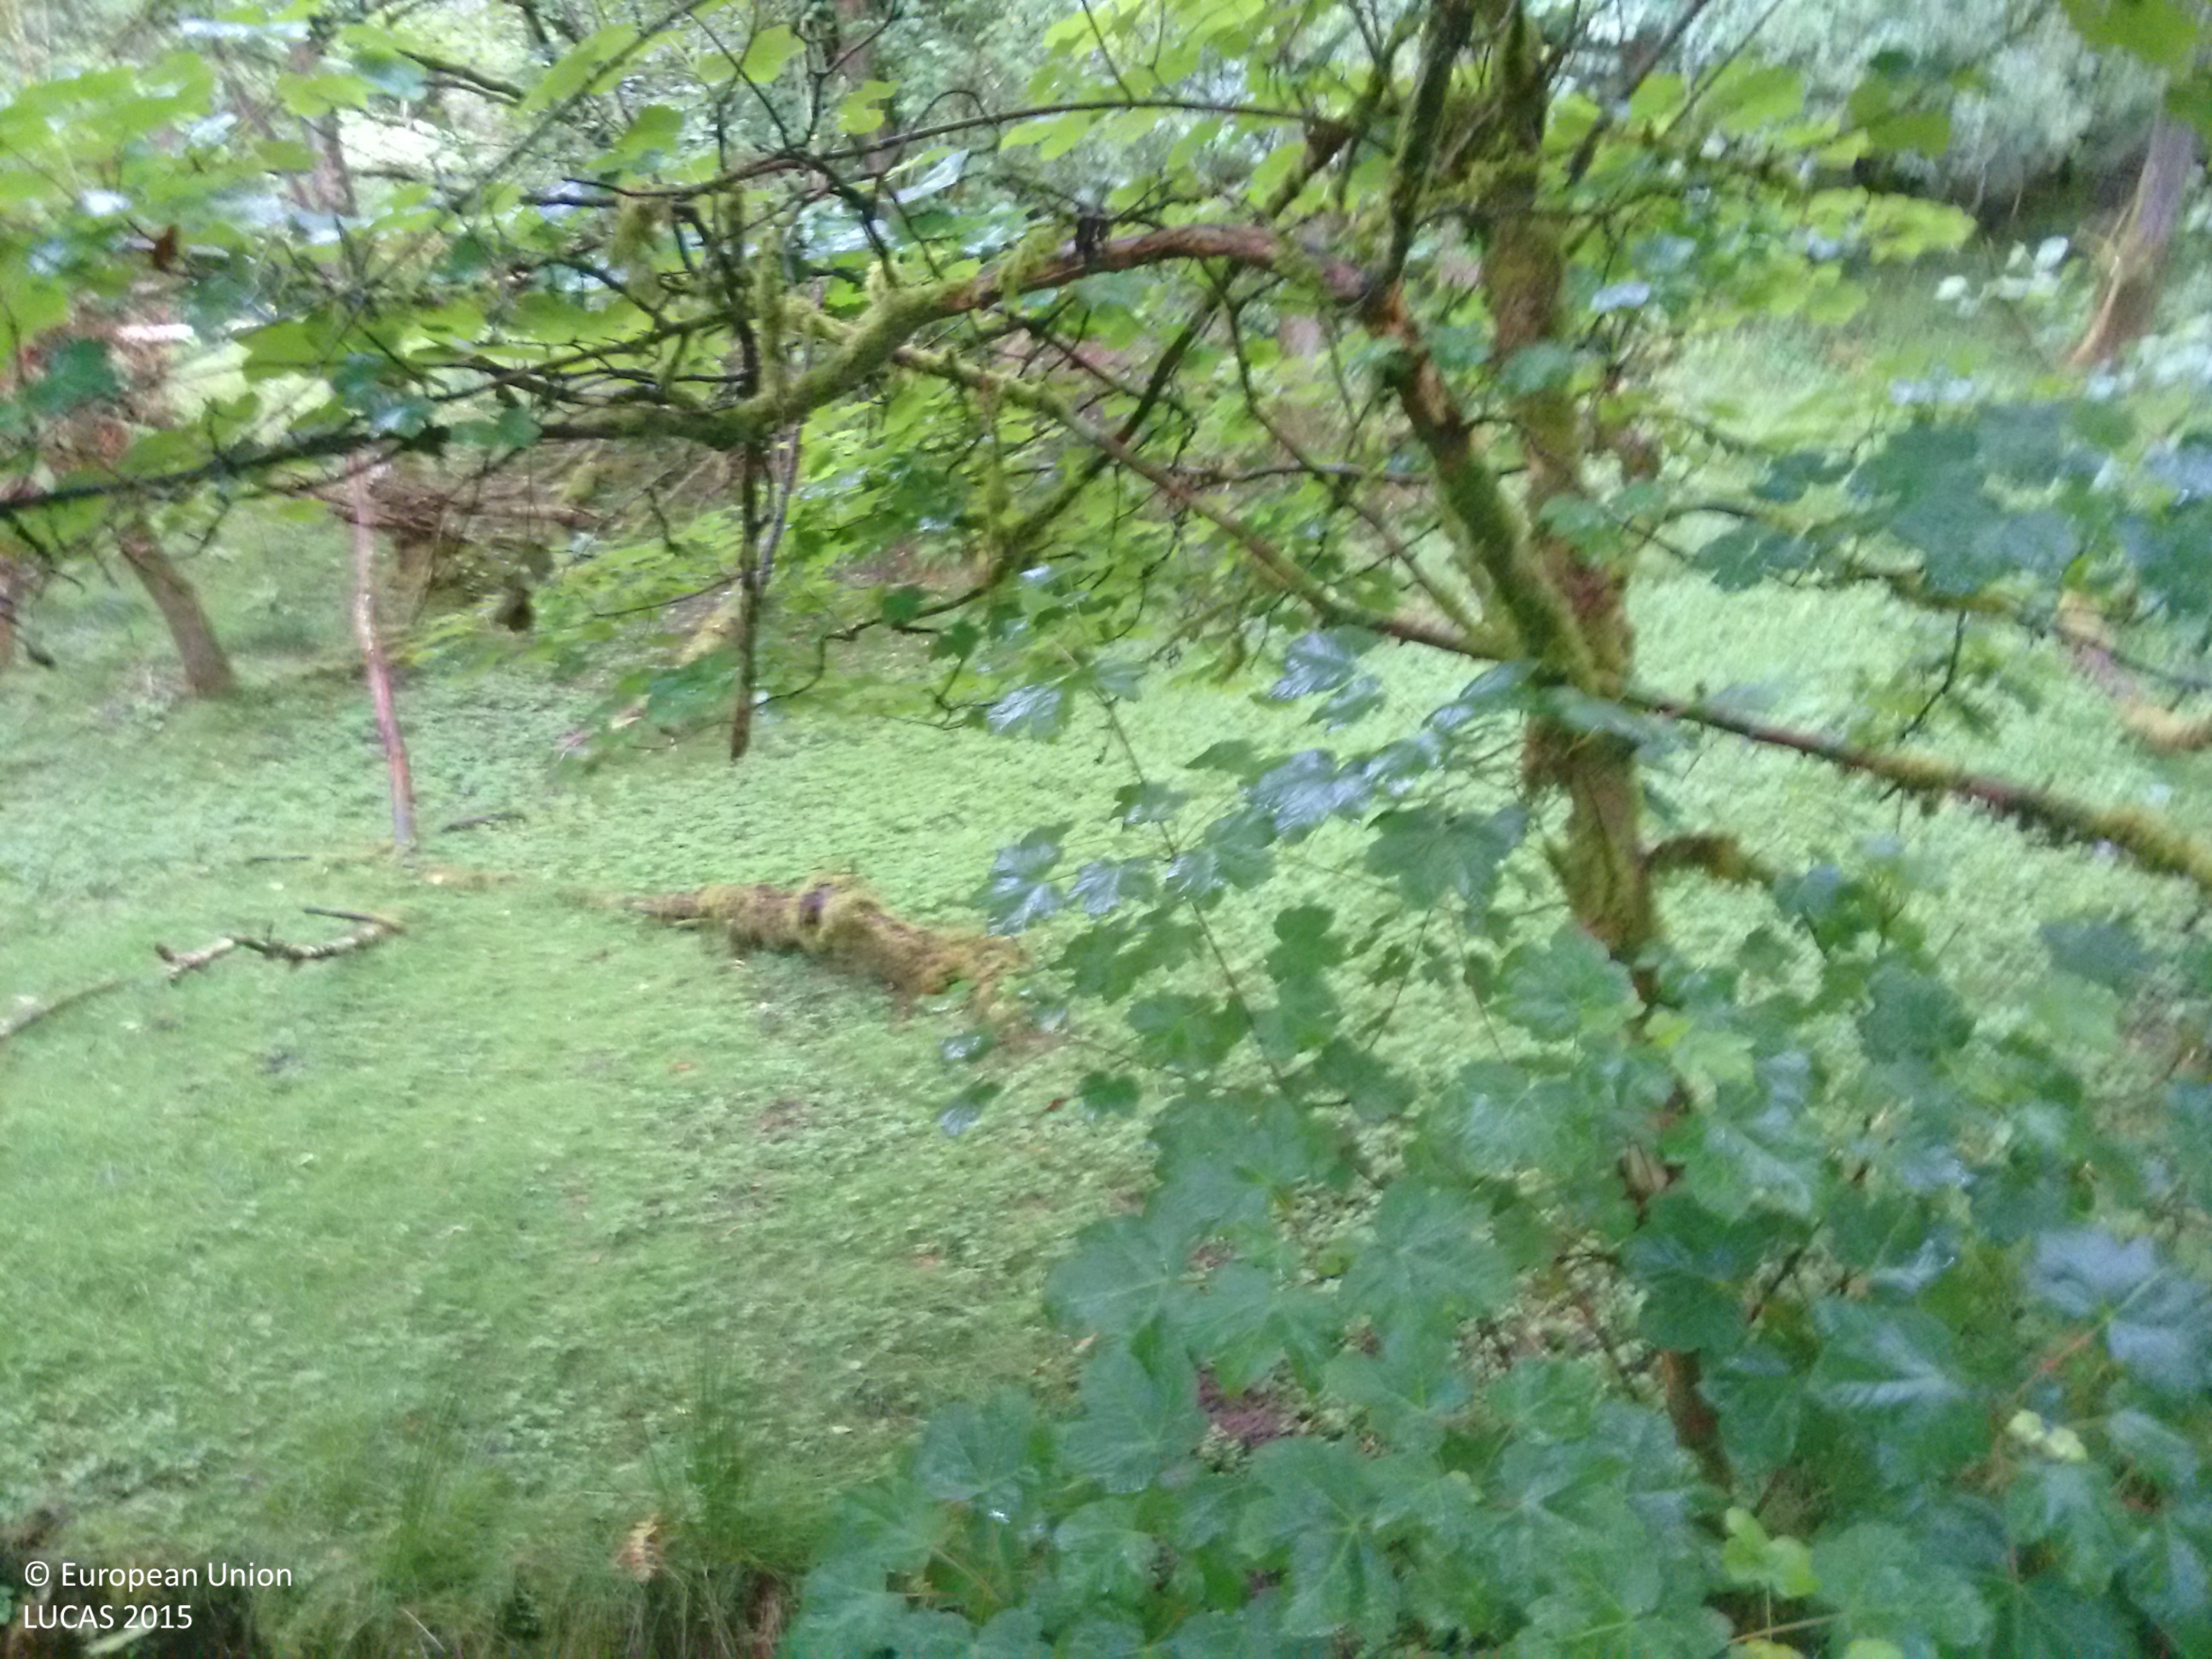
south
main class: Woodland
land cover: Broadleaved woodland
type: mesophytic deciduous forest
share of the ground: > 75 %
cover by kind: broadleaved forest trees 100 %
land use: Semi-natural and natural areas not in use
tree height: > 5 m
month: July
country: GB
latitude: 51.0115
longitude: -3.5546
